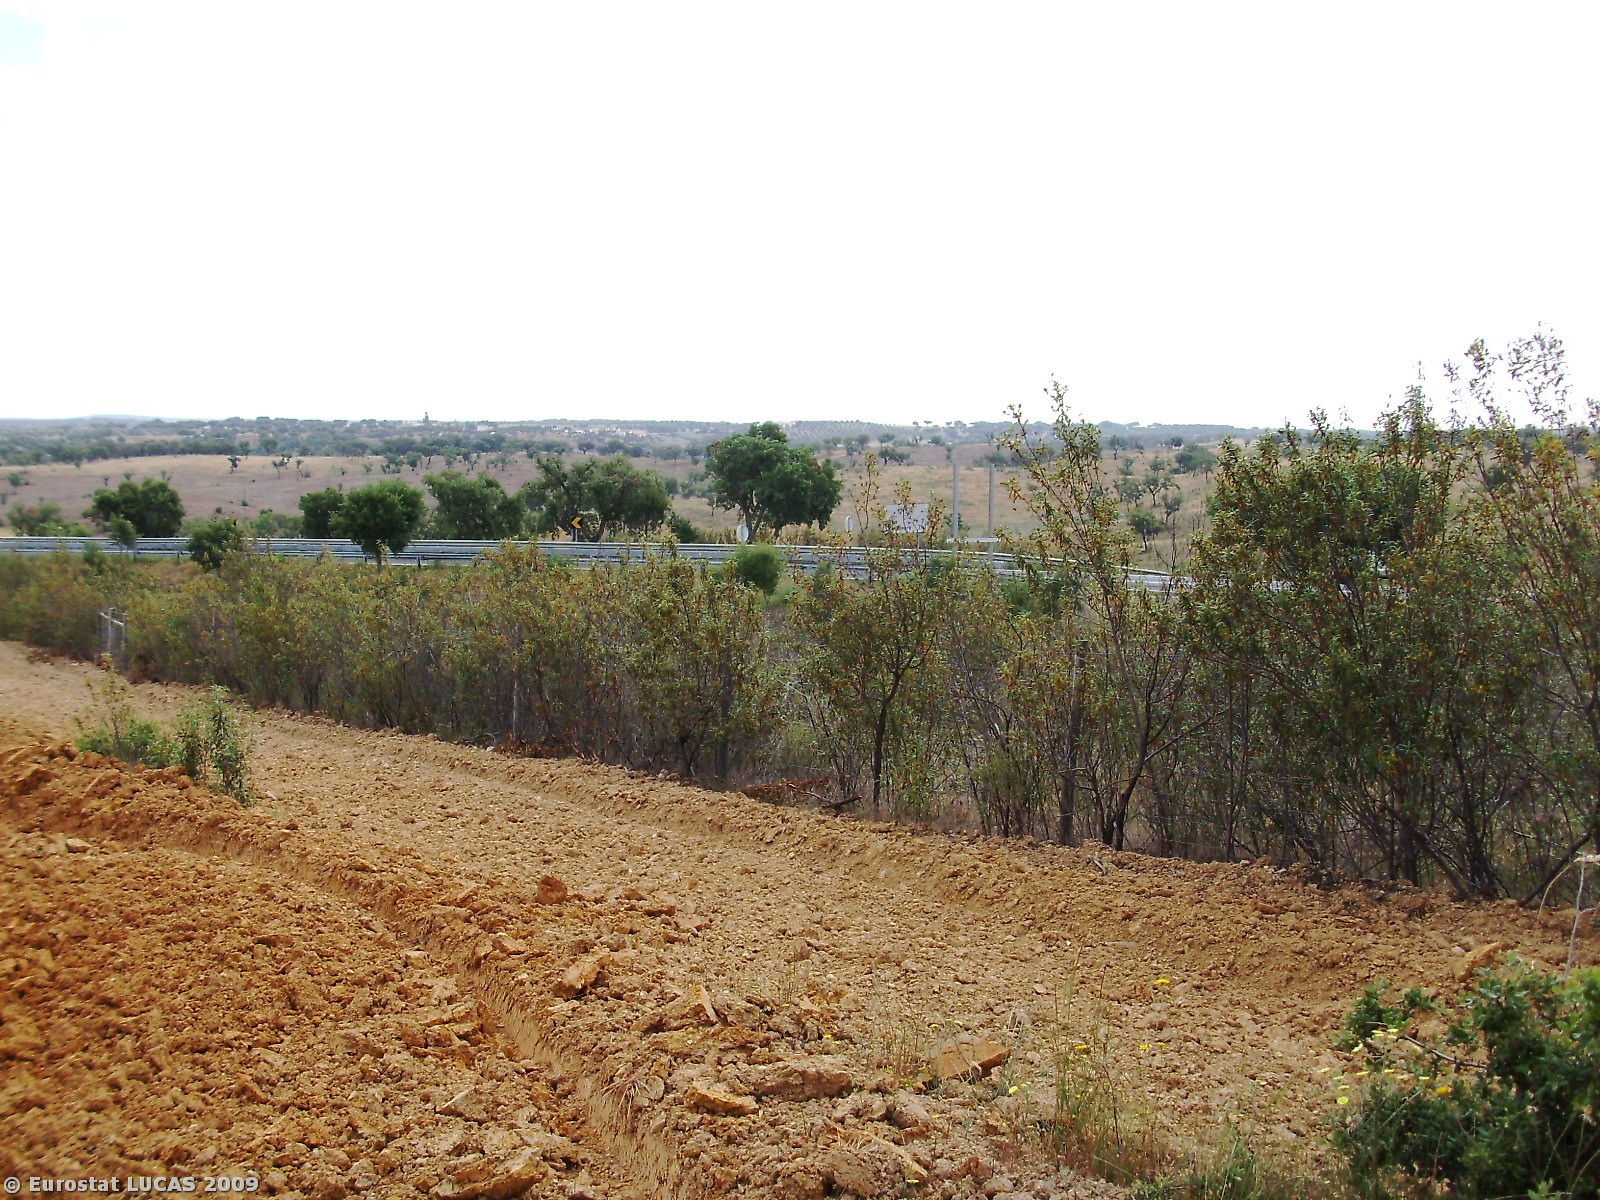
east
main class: Woodland
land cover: Broadleaved woodland
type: broadleaved evergreen forest
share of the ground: 50 - 75 %
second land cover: Spontaneously vegetated surfaces
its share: 25 - 50 %
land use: Forestry
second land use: Fallow land
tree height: > 5 m
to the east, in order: Broadleaved woodland; Spontaneously vegetated surfaces; Fences; Shrubland with sparse tree cover; Paved roads, cycling and walking lanes; Fences; Broadleaved woodland
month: May
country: PT
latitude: 39.0058
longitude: -7.9357
